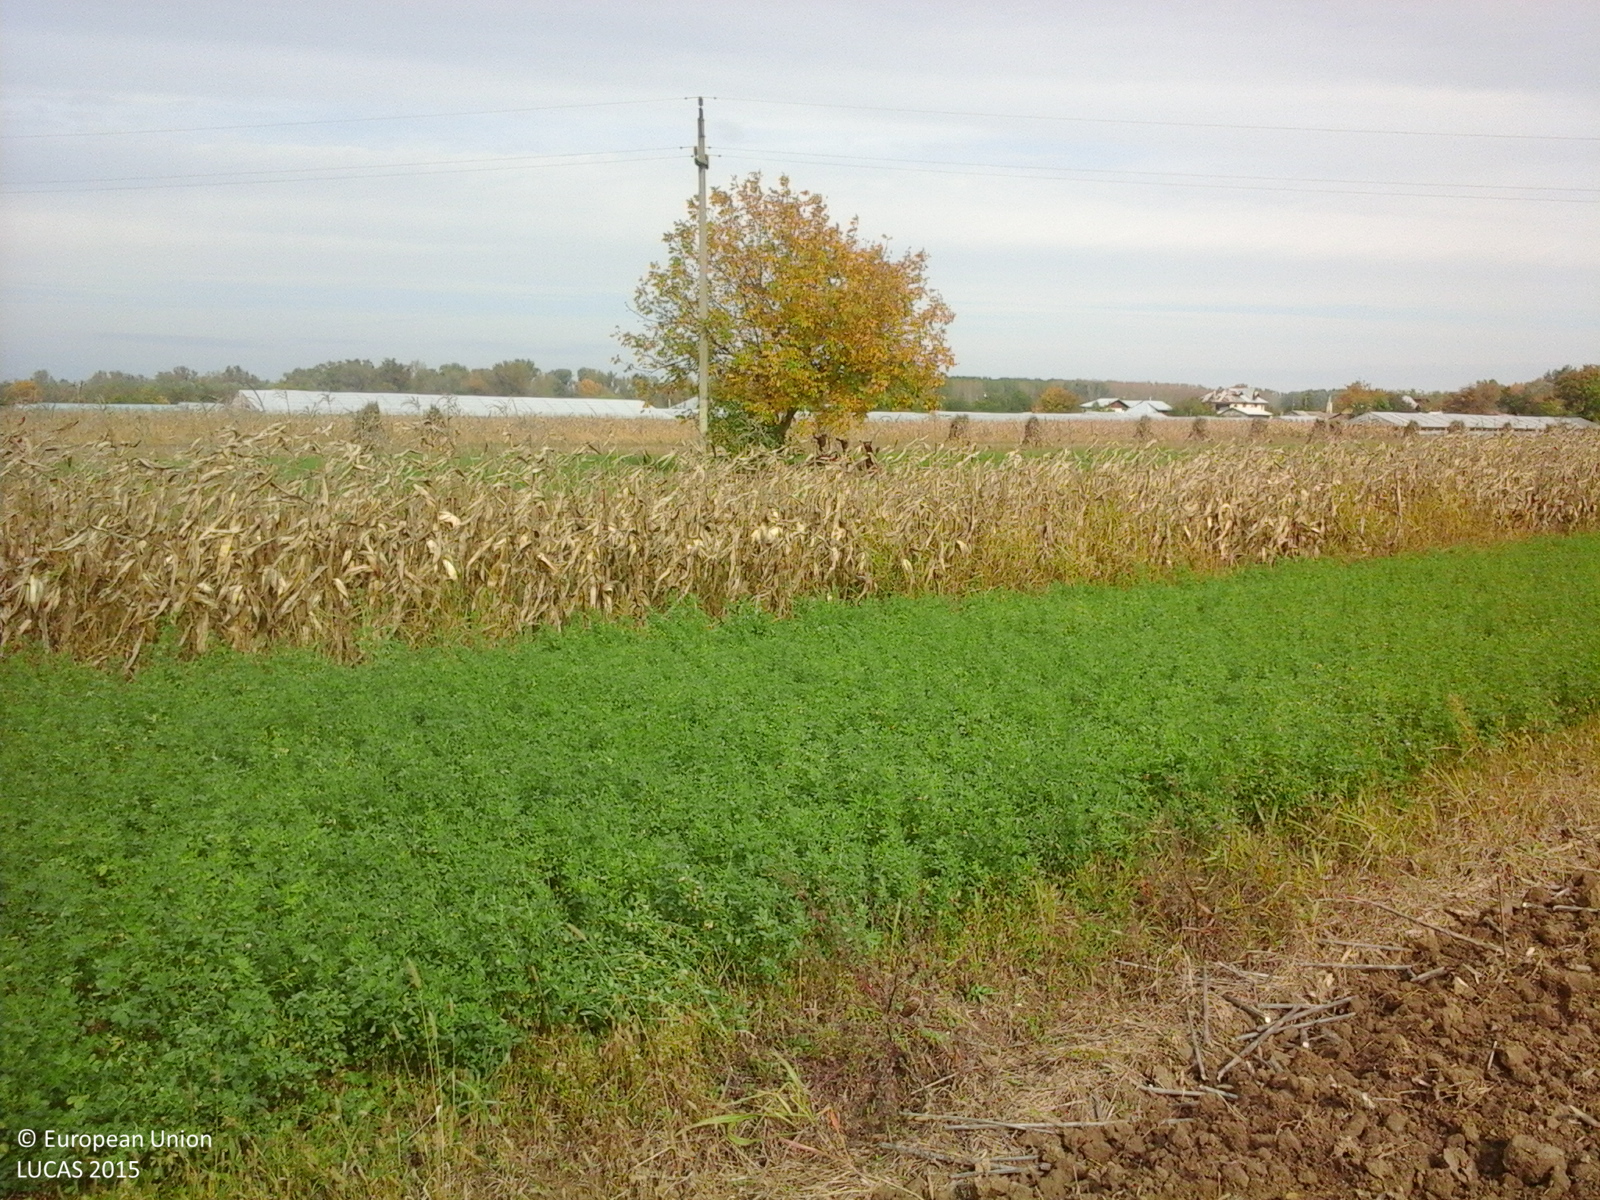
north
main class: Cropland
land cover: Maize
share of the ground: < 10 %
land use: Agriculture (excluding fallow land and kitchen gardens)
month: October
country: RO
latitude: 44.8362
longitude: 26.1633
